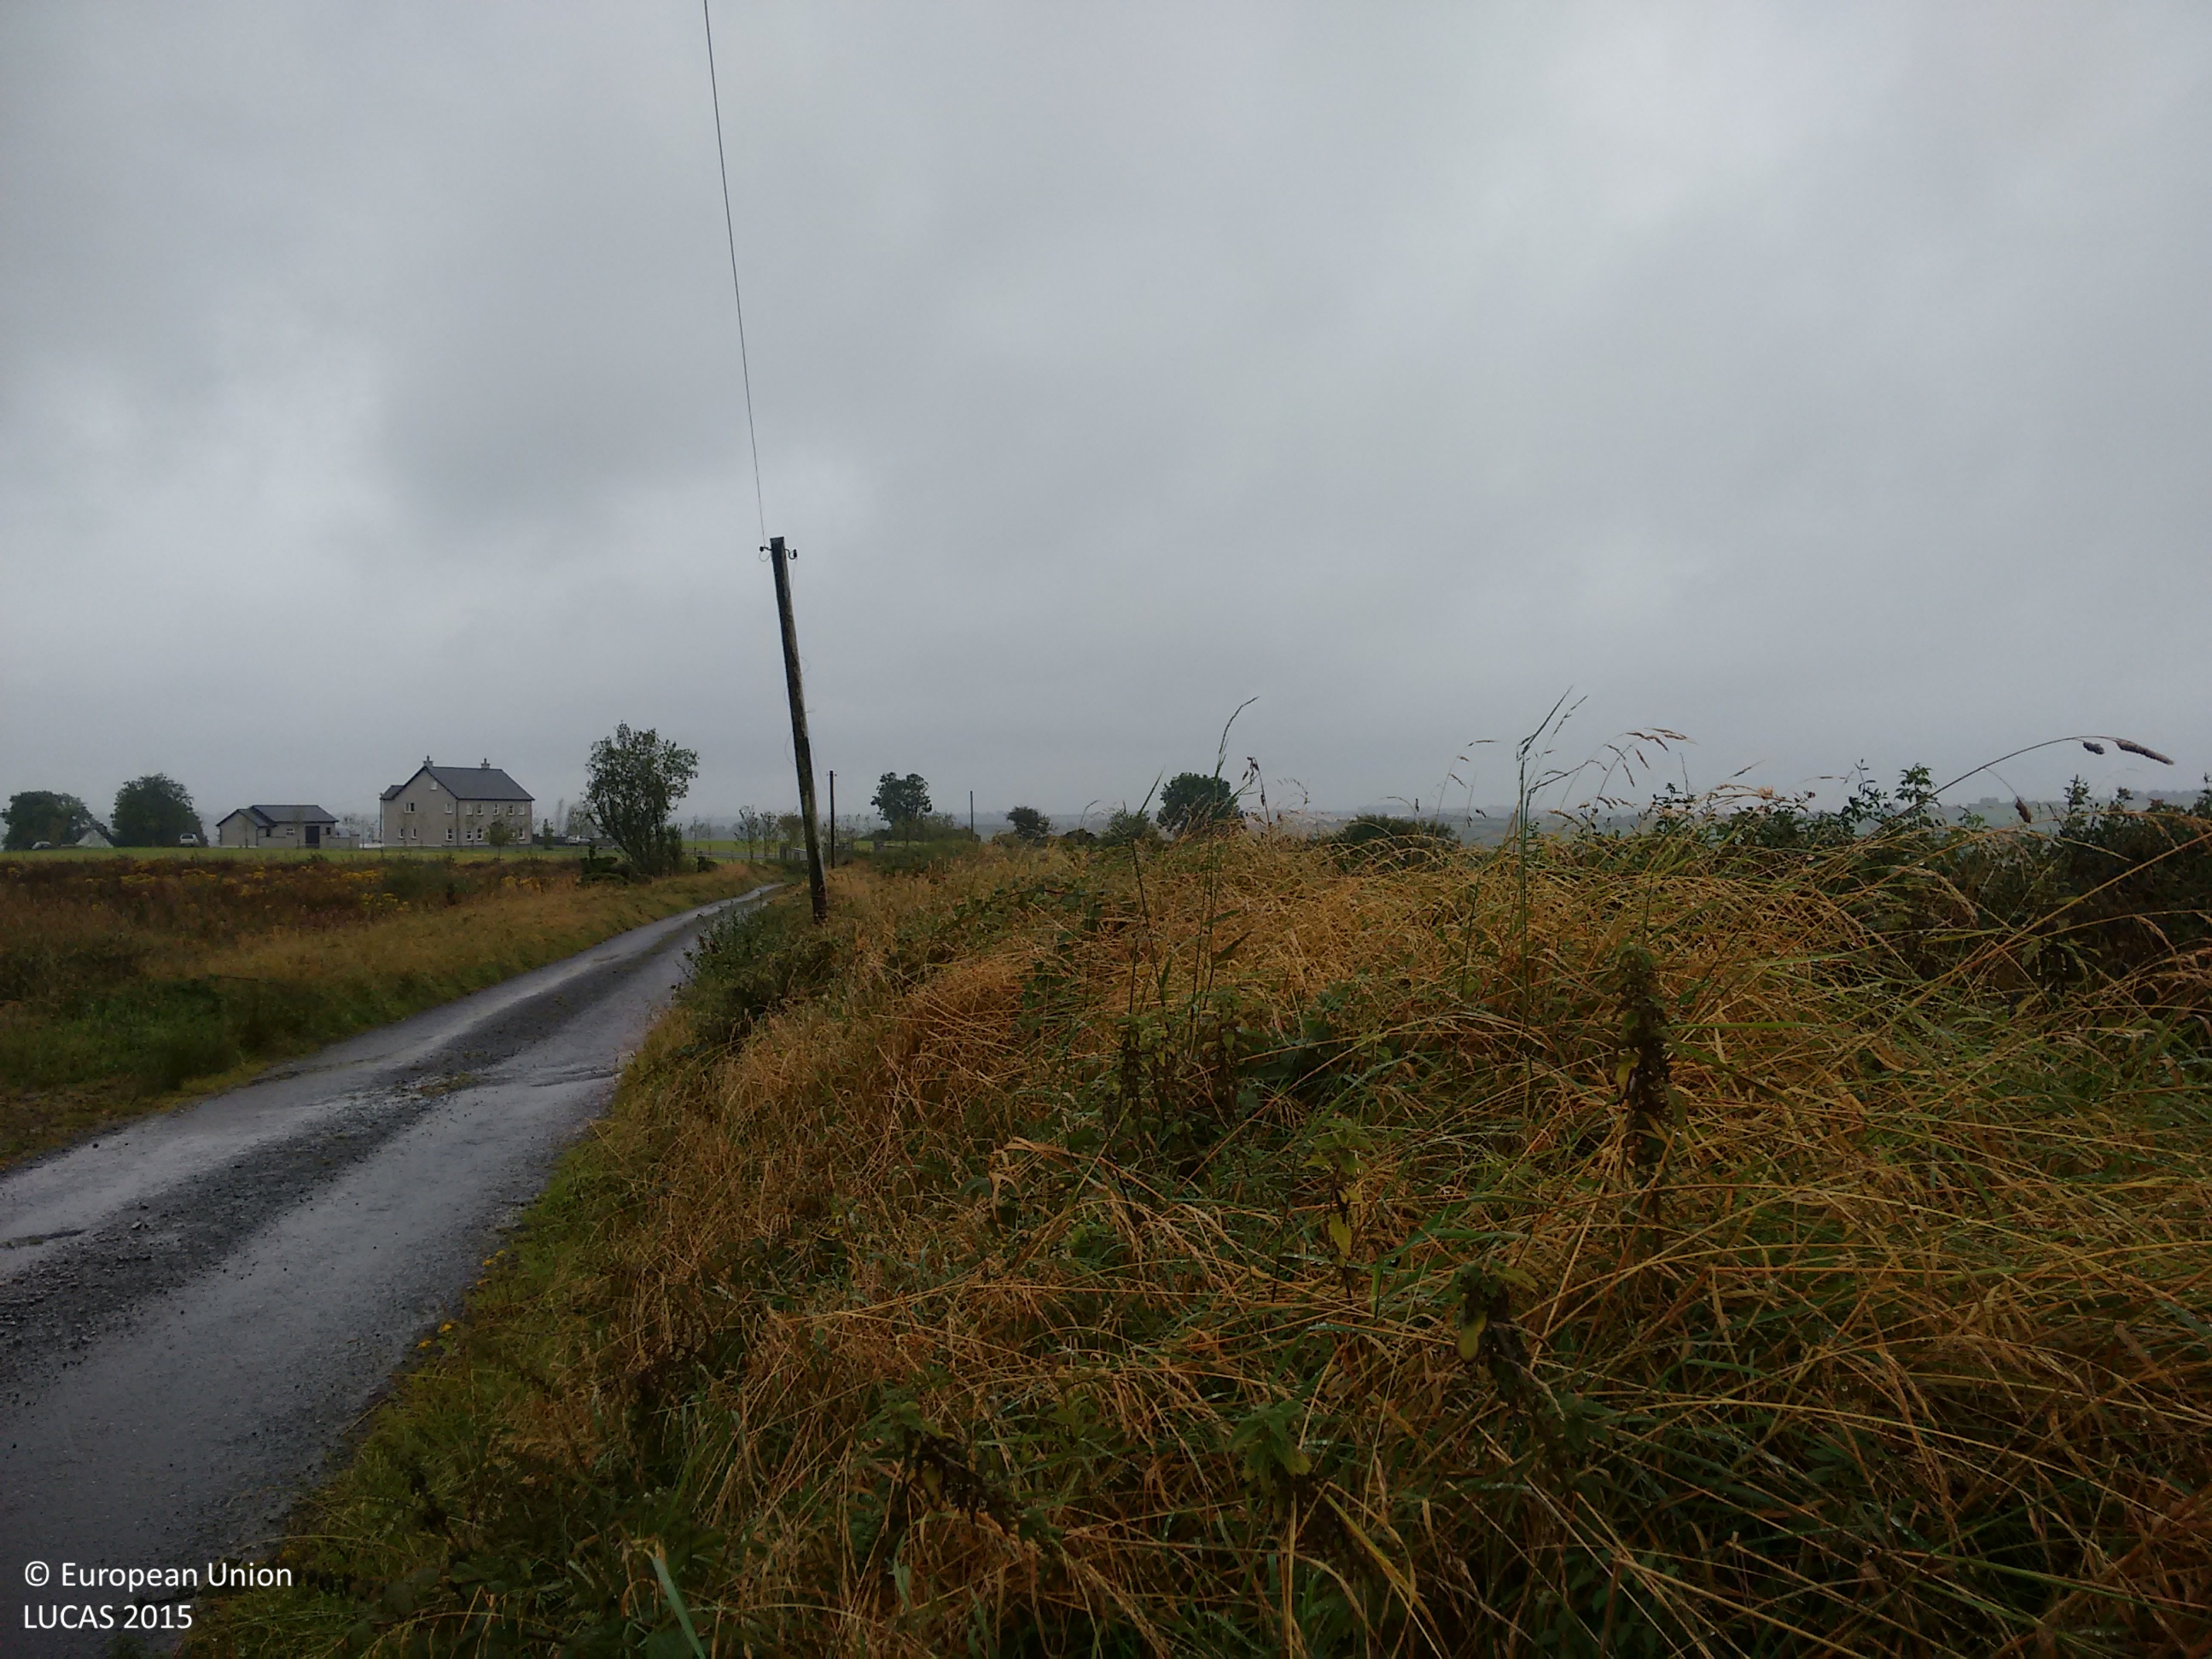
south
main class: Grassland
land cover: Grassland without tree/shrub cover
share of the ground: > 75 %
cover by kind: herbaceous plants 70 %, consolidated bare surface 15 %, shrubs 5 %
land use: Agriculture (excluding fallow land and kitchen gardens)
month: September
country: IE
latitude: 52.2017
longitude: -9.0460
